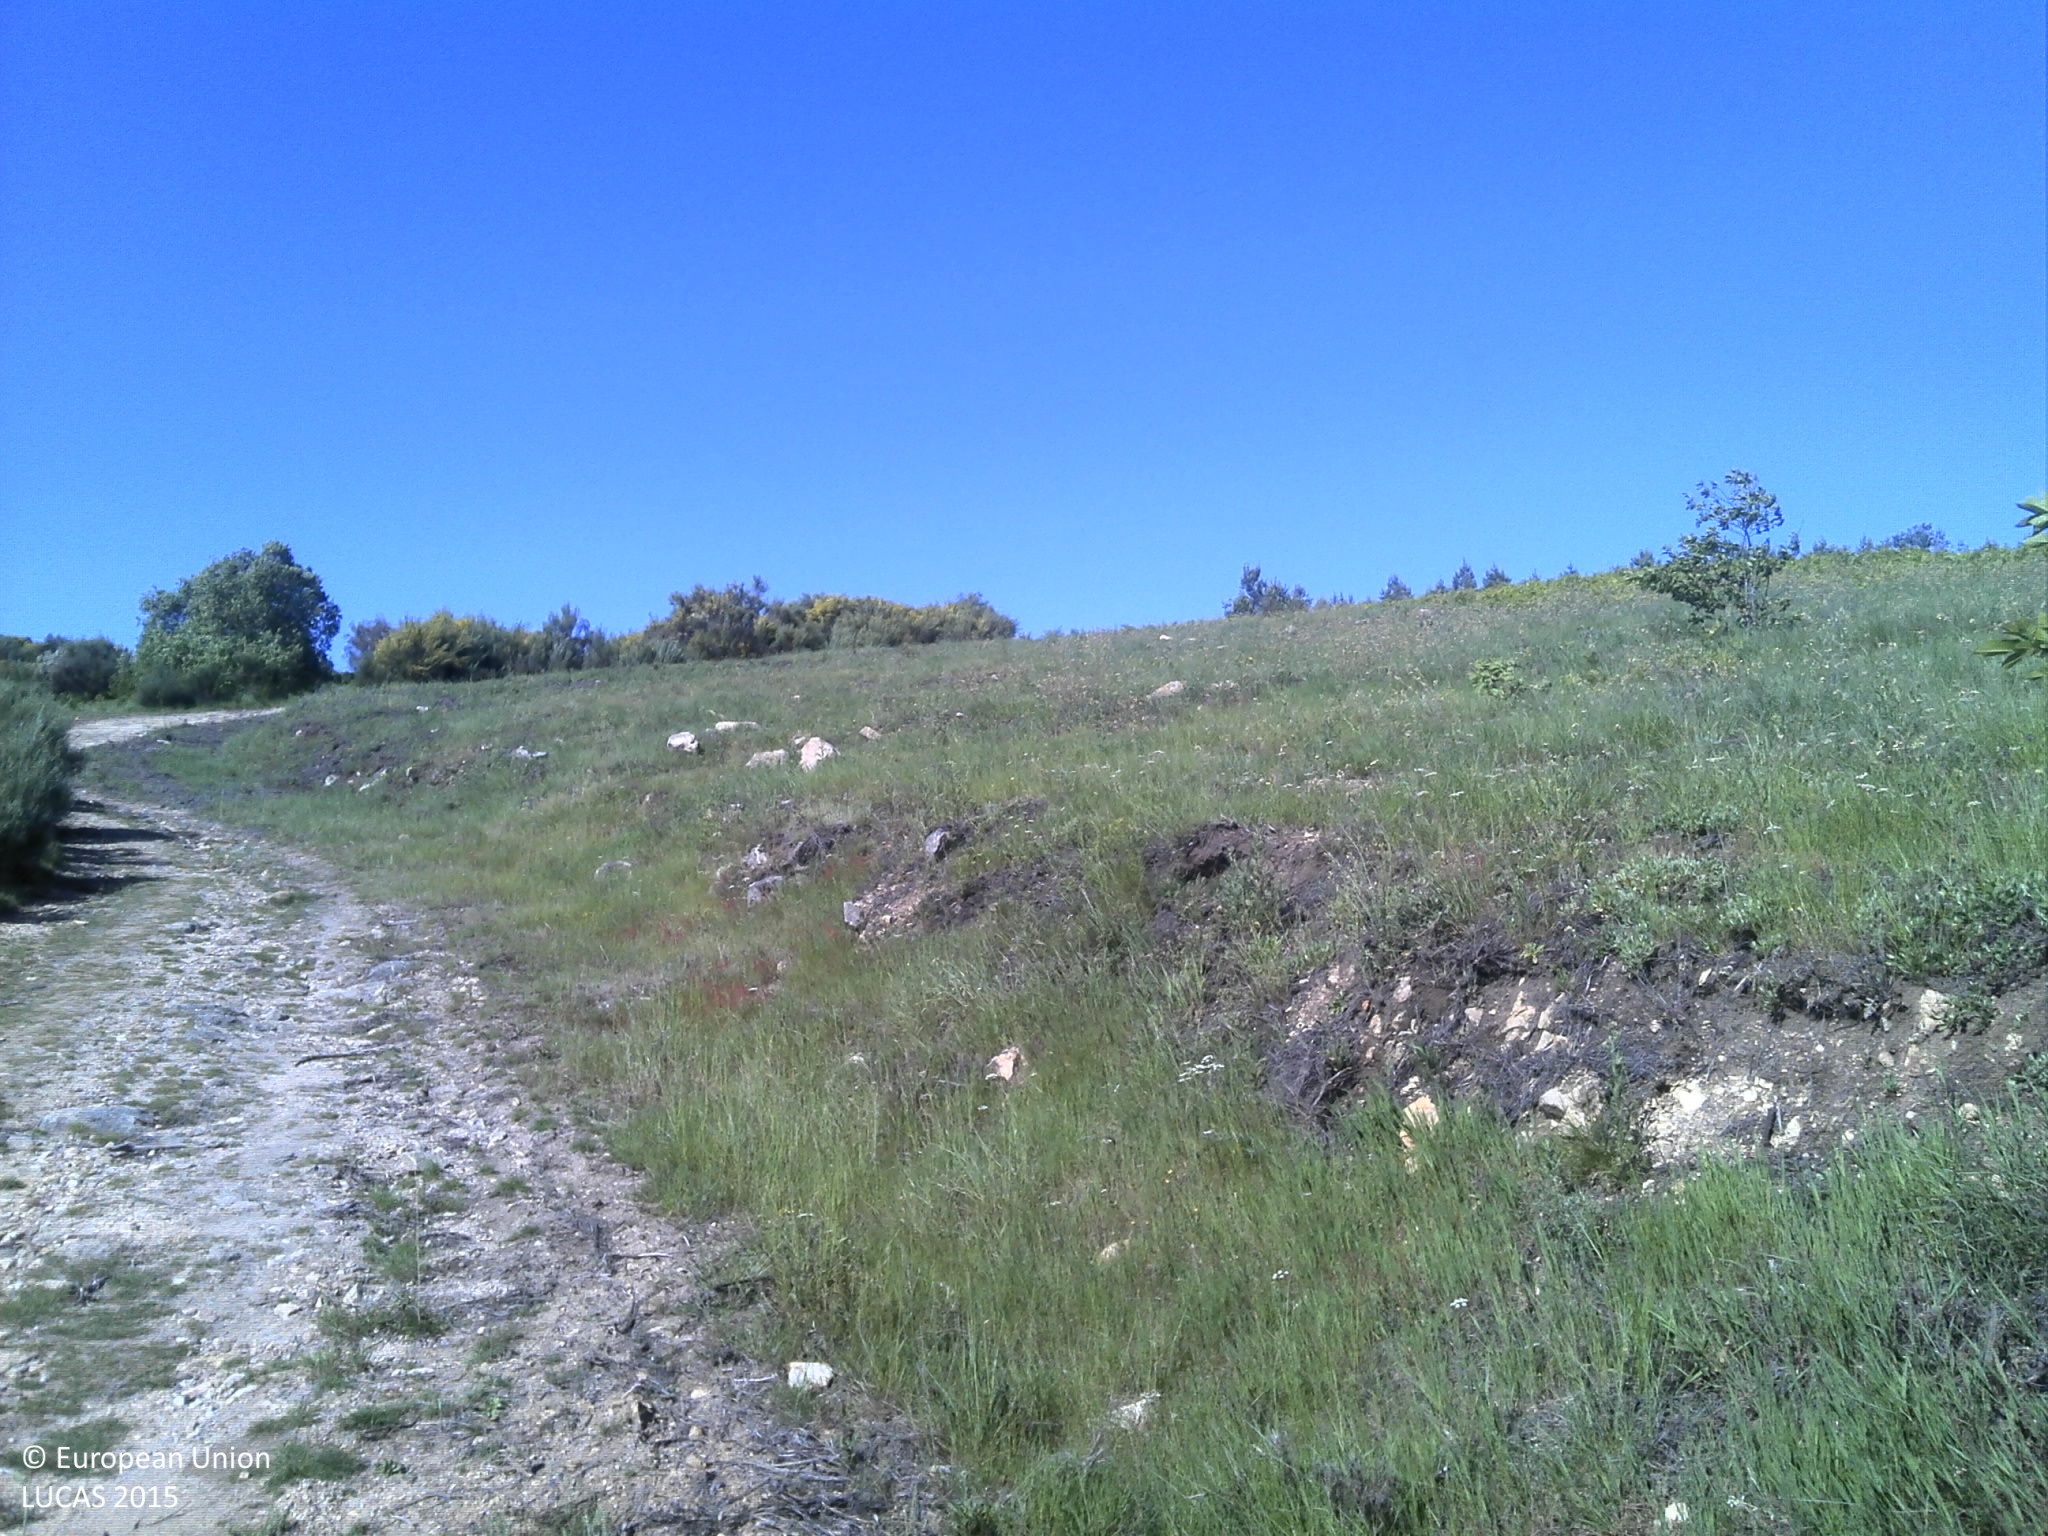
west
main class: Shrubland
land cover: Shrubland without tree cover
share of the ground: > 75 %
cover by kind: shrubs 75 %, herbaceous plants 15 %, unconsolidated bare surface 10 %
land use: Semi-natural and natural areas not in use
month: May
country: PT
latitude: 40.5429
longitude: -7.4071
